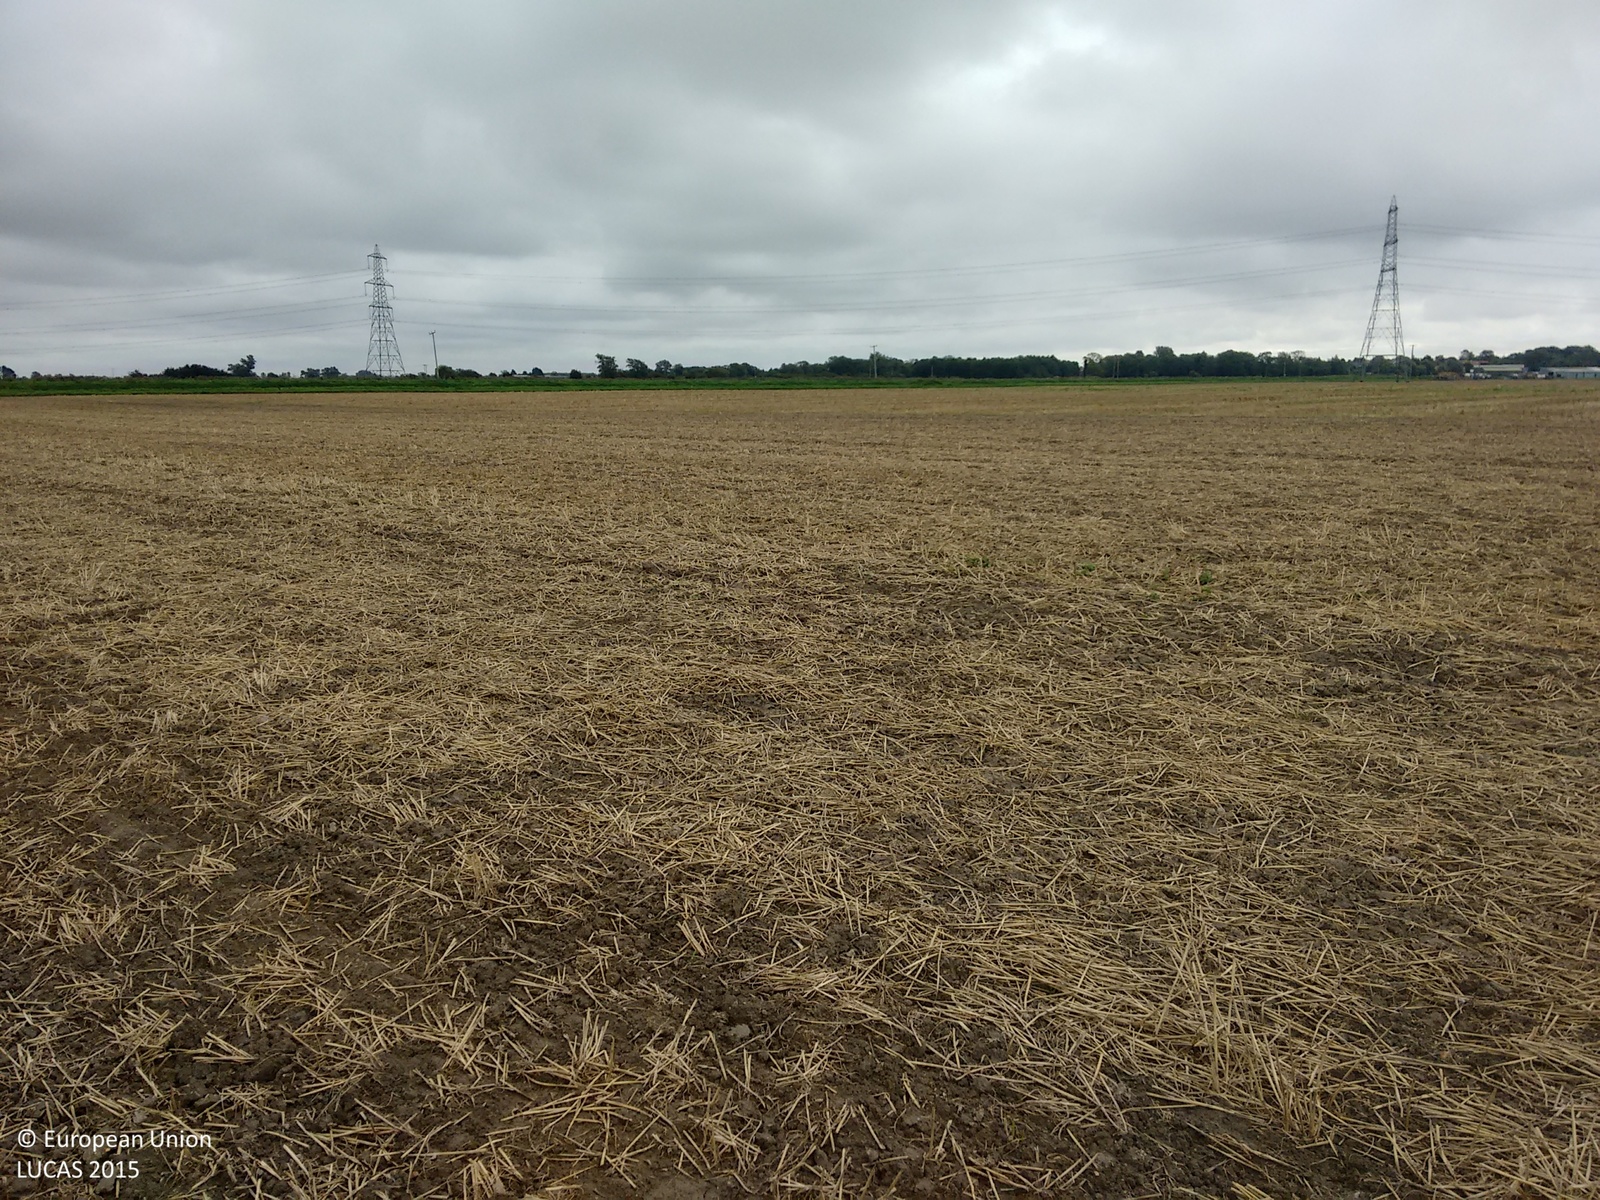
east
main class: Cropland
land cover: Common wheat
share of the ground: 25 - 50 %
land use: Agriculture (excluding fallow land and kitchen gardens)
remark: Harvested field
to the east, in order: Common wheat
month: September
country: GB
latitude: 52.2880
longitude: 0.3094
